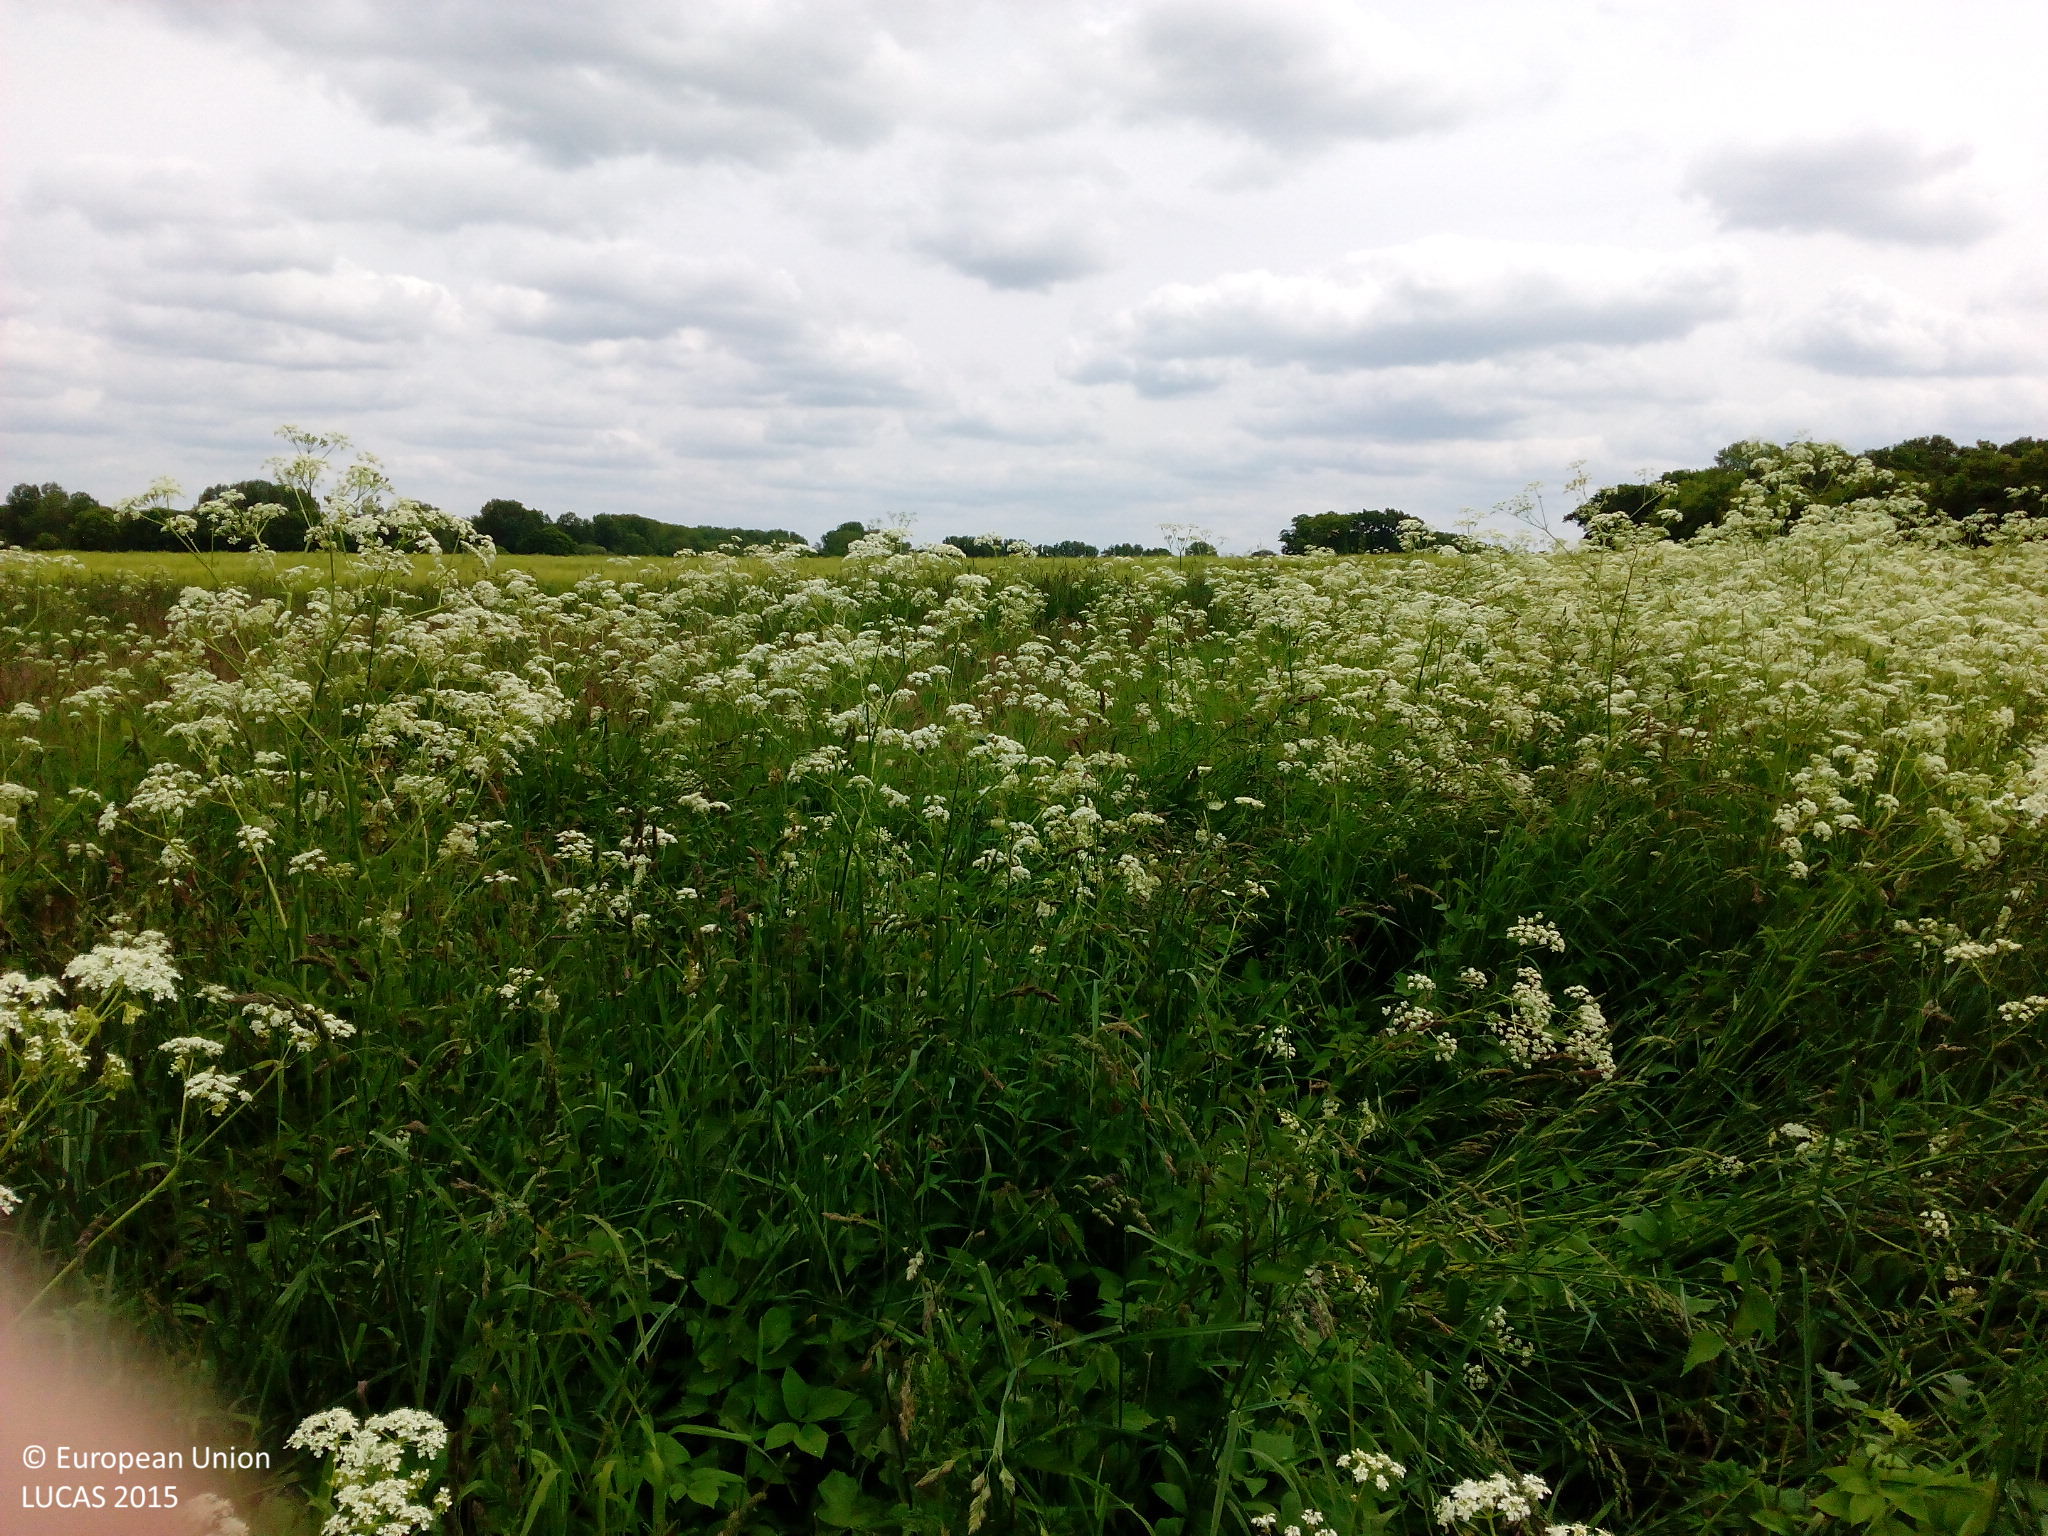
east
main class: Grassland
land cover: Grassland without tree/shrub cover
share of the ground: > 75 %
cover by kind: herbaceous plants 100 %
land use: Agriculture (excluding fallow land and kitchen gardens)
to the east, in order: Grassland without tree/shrub cover; Triticale
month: June
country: DE
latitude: 52.3125
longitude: 7.3747
